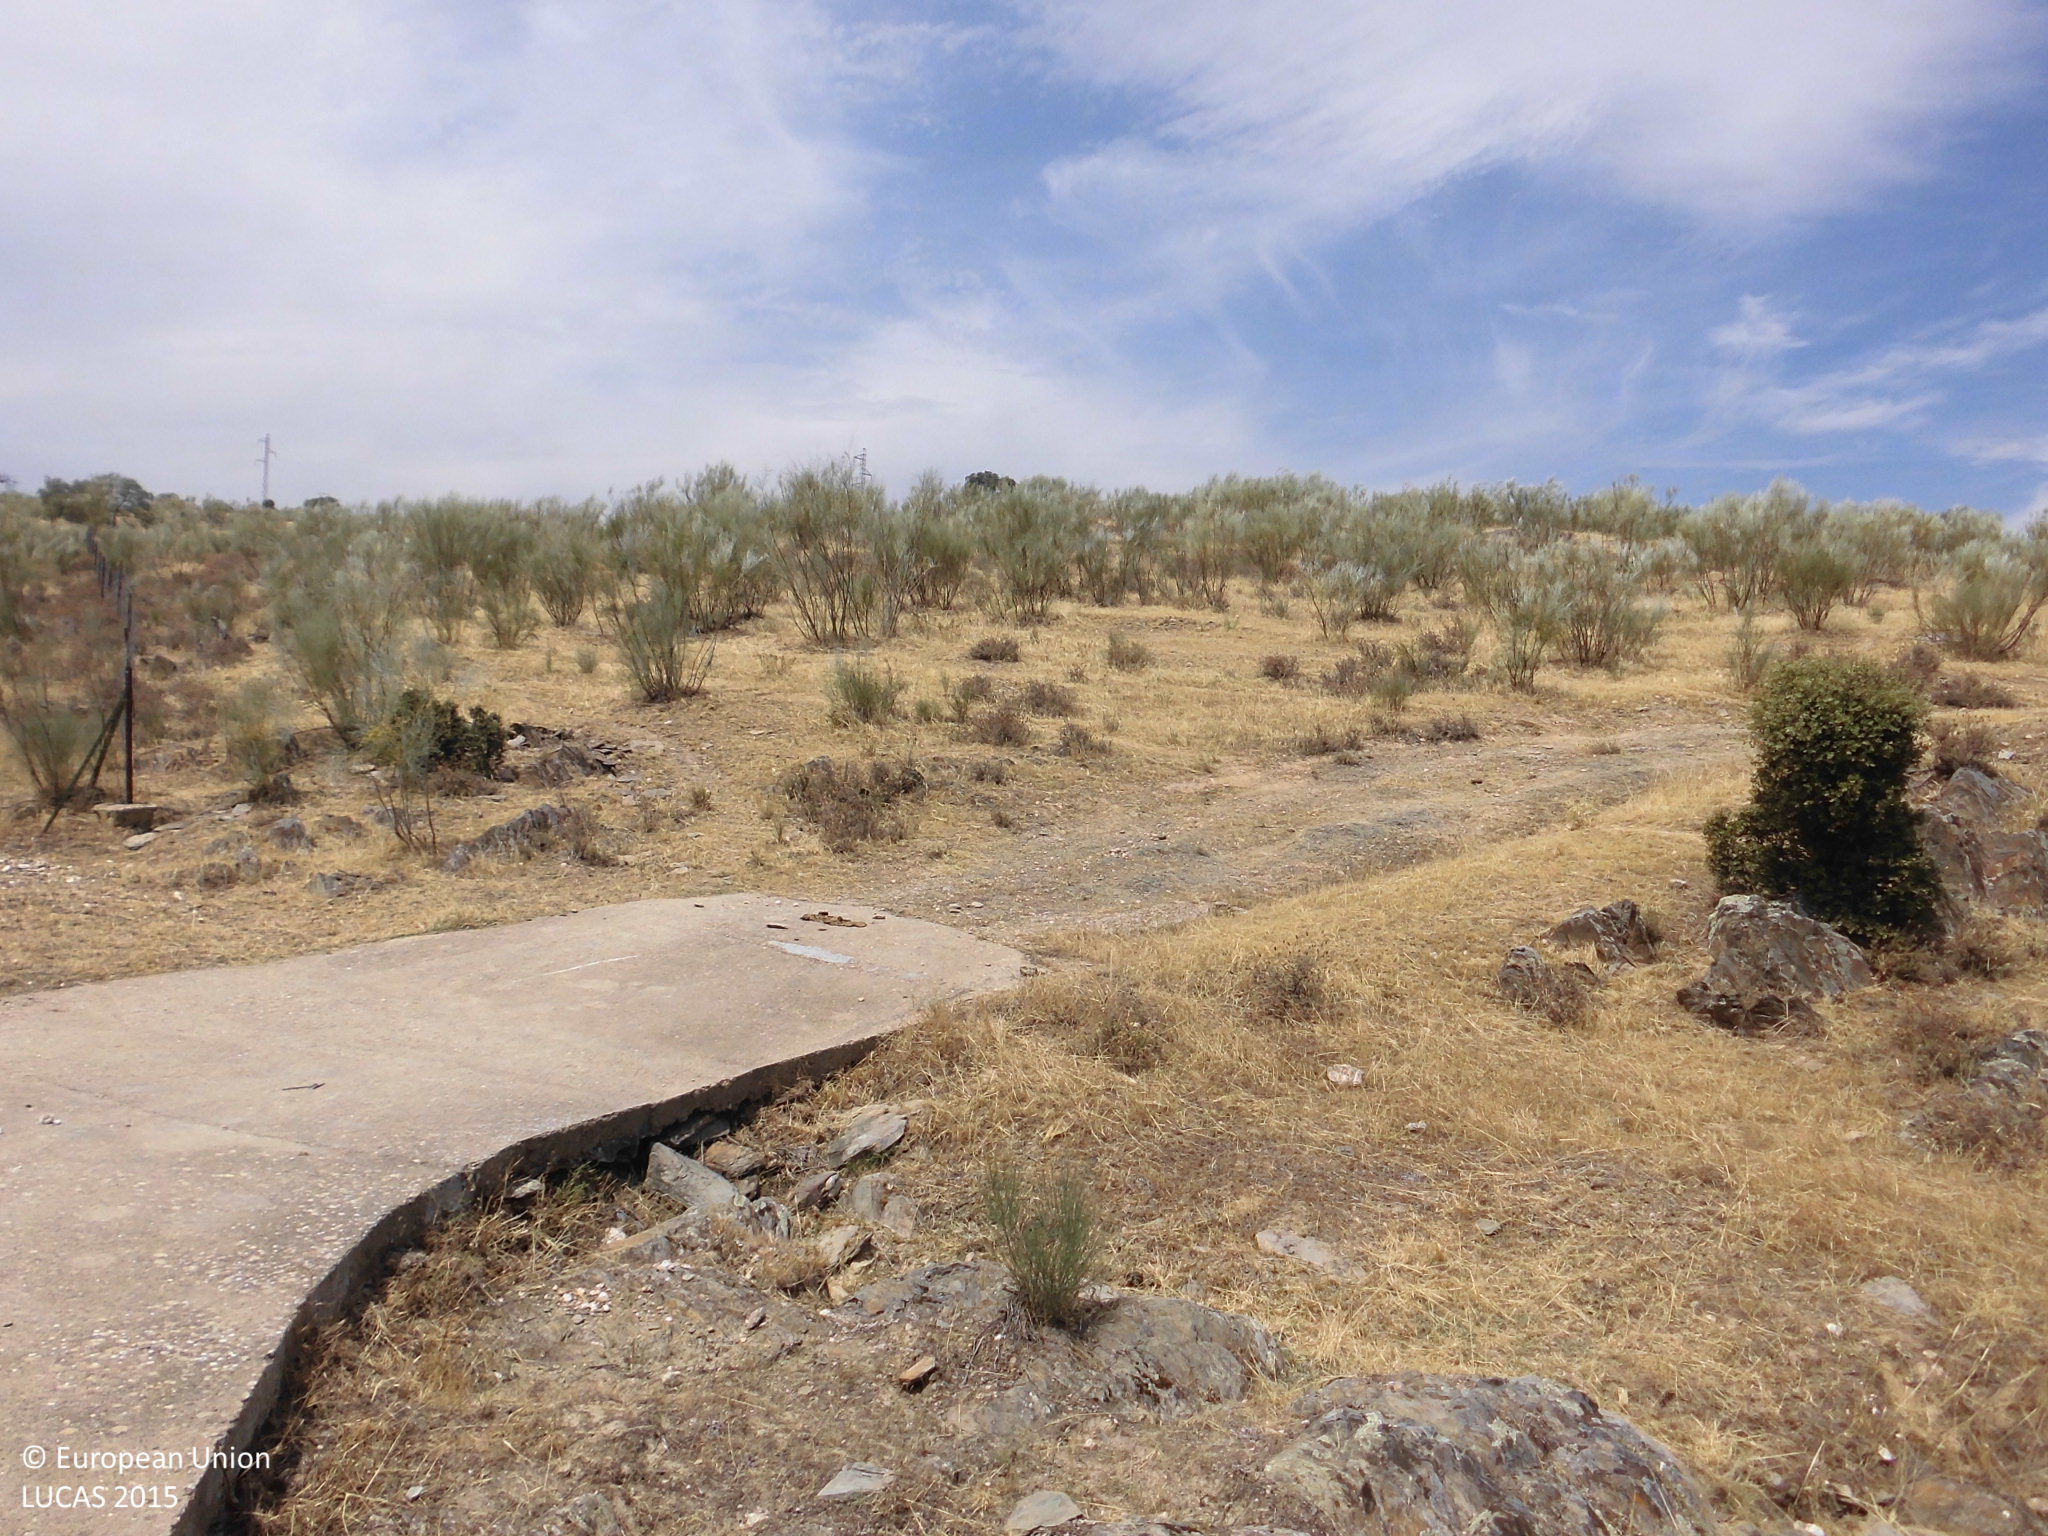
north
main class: Shrubland
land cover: Shrubland without tree cover
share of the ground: 10 - 25 %
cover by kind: herbaceous plants 85 %, shrubs 15 %
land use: Agriculture (excluding fallow land and kitchen gardens)
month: July
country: ES
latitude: 39.7661
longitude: -6.4764
